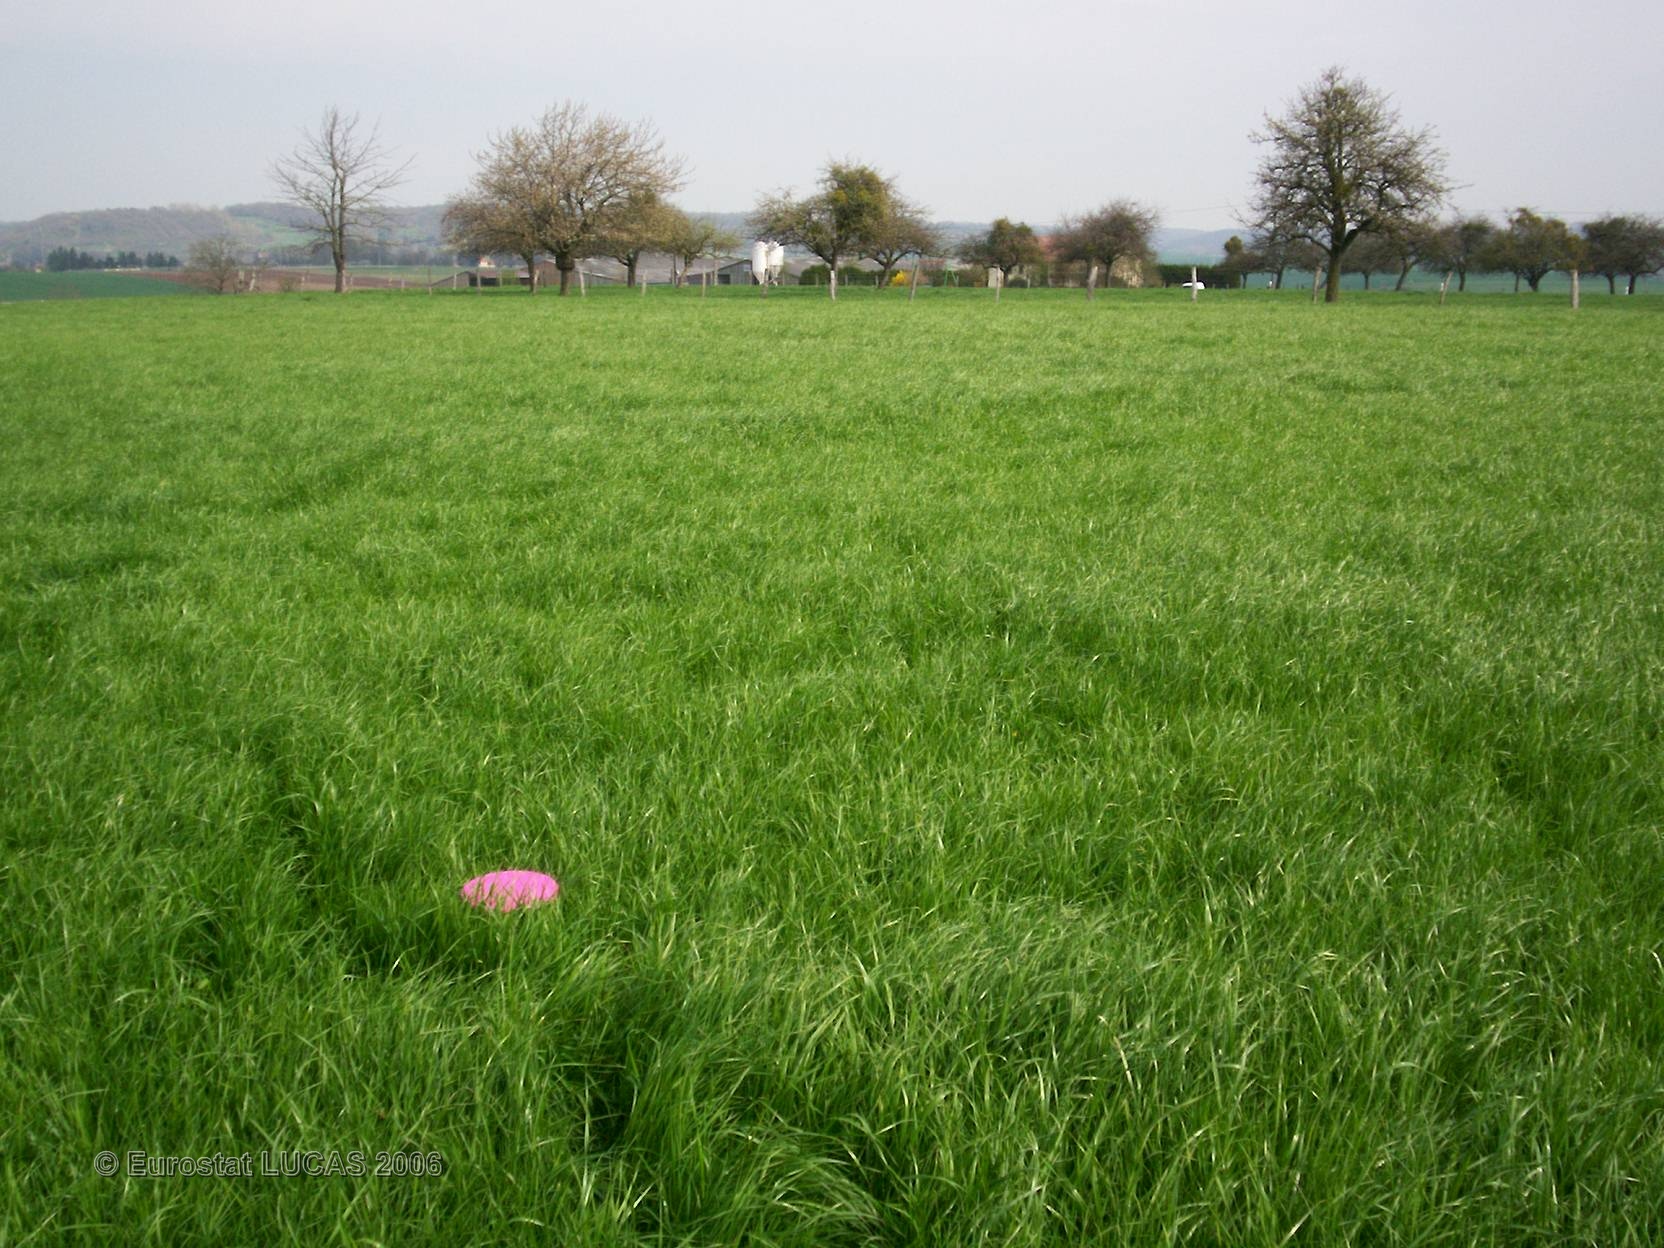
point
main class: Grassland
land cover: Grassland without tree/shrub cover
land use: Agriculture (excluding fallow land and kitchen gardens)
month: April
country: FR
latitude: 48.7633
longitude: 6.5312
